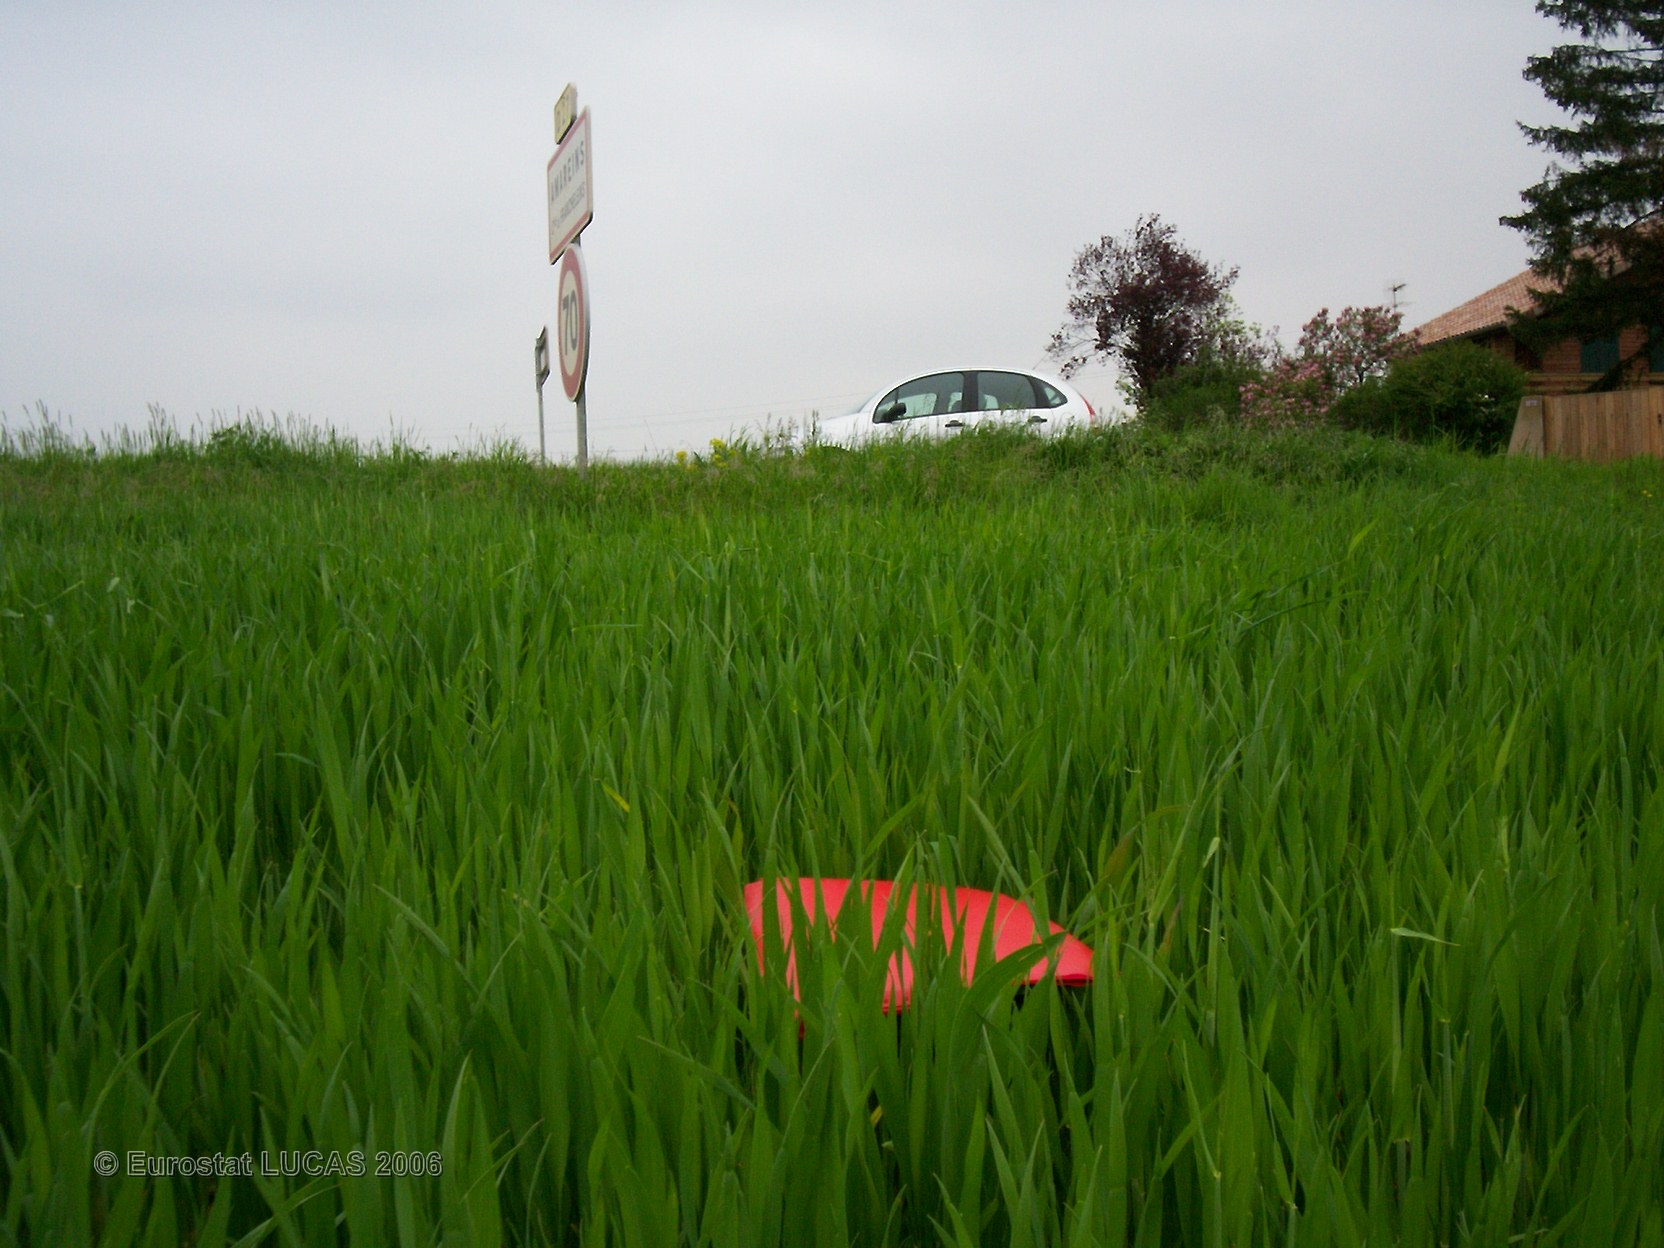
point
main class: Cropland
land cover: Common wheat
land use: Agriculture (excluding fallow land and kitchen gardens)
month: April
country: FR
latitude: 46.0799
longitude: 4.7915
